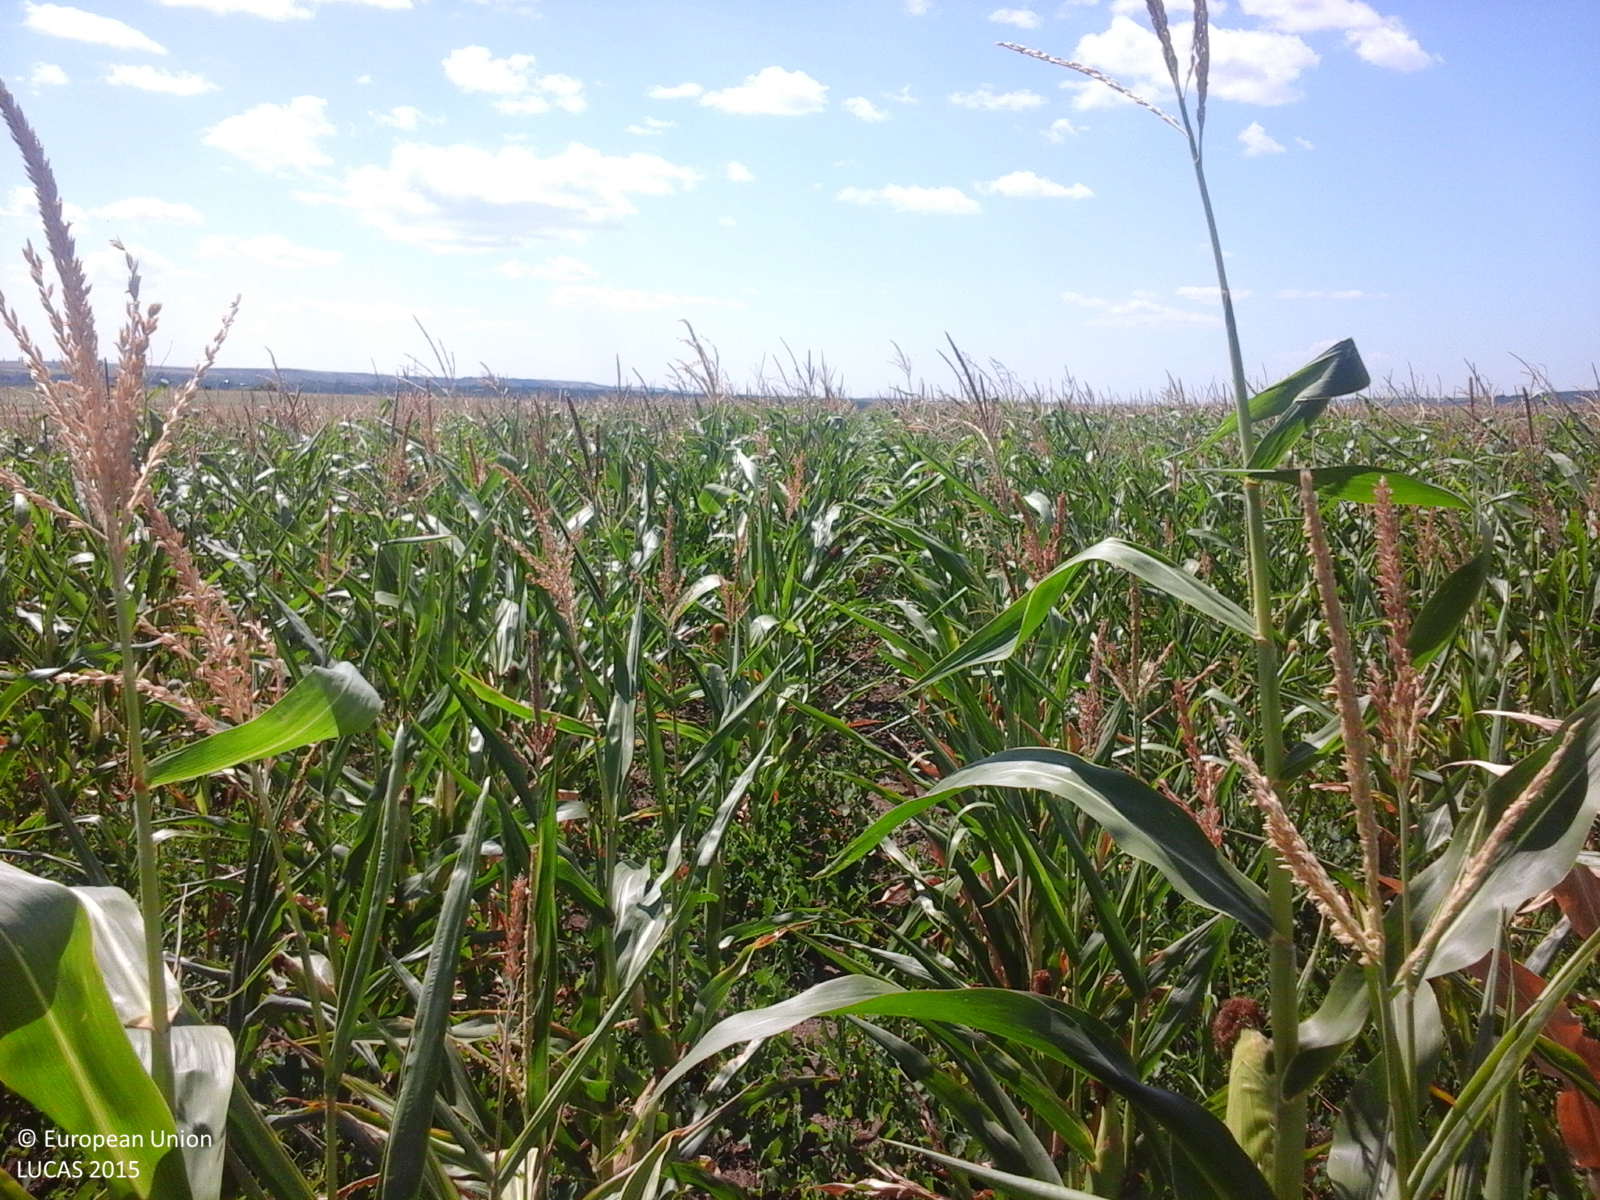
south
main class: Cropland
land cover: Maize
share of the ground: > 75 %
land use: Agriculture (excluding fallow land and kitchen gardens)
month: July
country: RO
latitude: 46.0771
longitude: 27.4720
